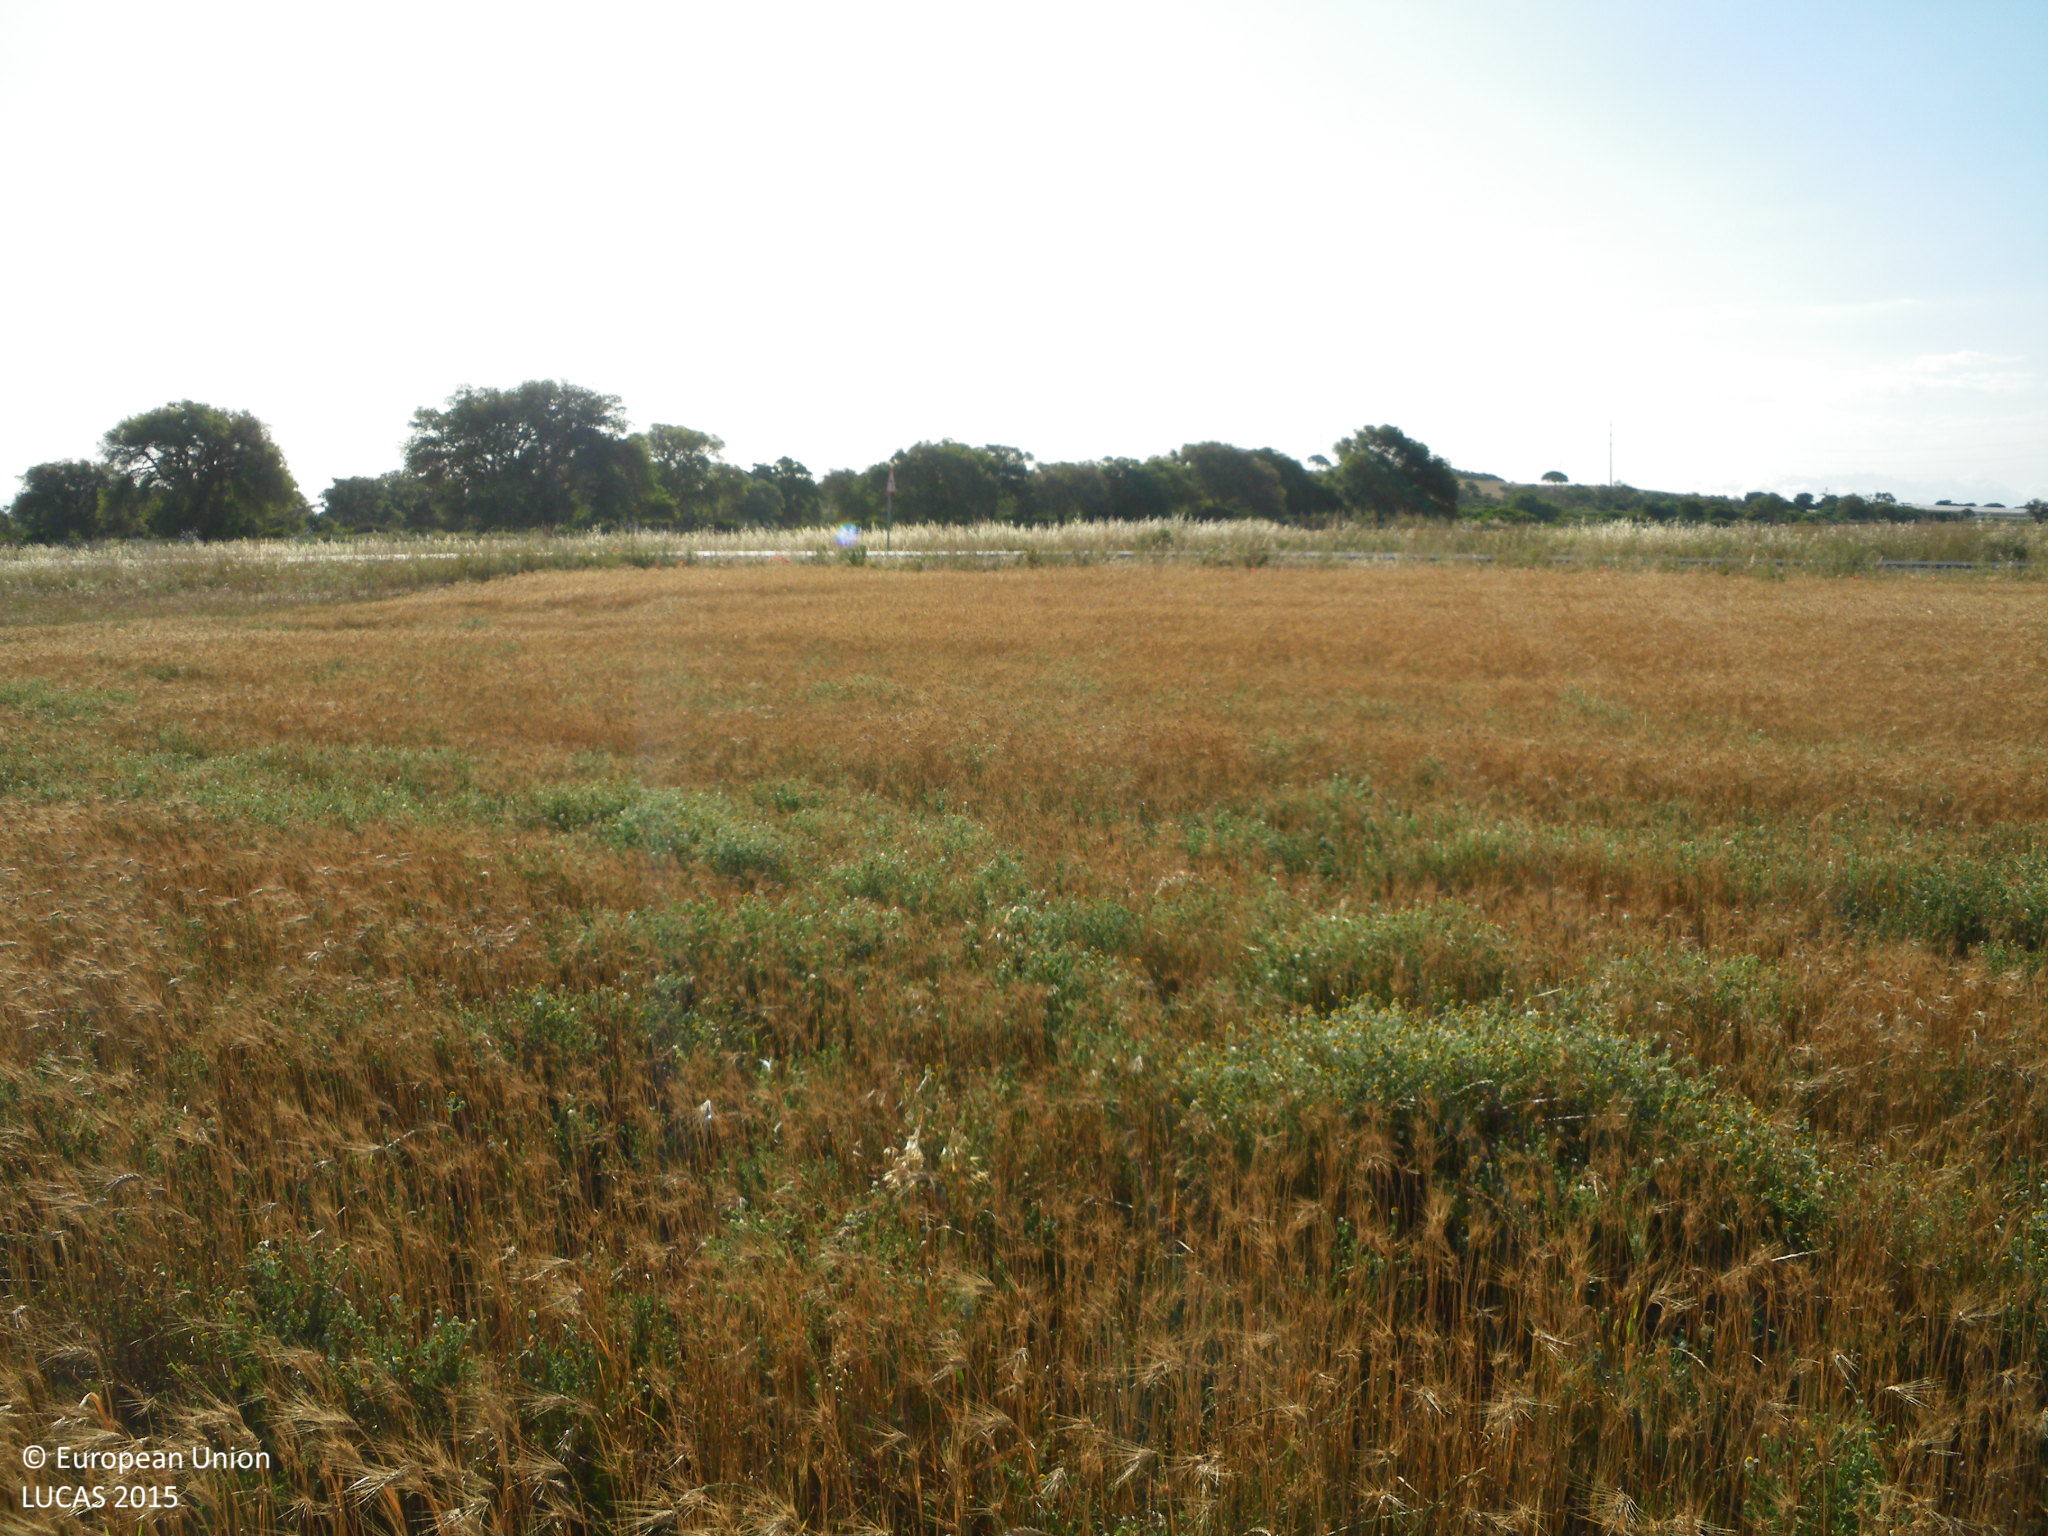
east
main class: Cropland
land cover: Durum wheat
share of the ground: > 75 %
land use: Agriculture (excluding fallow land and kitchen gardens)
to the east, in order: Durum wheat; Grassland without tree/shrub cover; Ditches and canals; Grass margins; Paved roads, cycling and walking lanes; Grass margins; Ditches and canals; Grass margins; Fences; Grass margins; Triticale; Fences; Broadleaved woodland
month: May
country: ES
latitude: 36.3541
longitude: -6.0621
